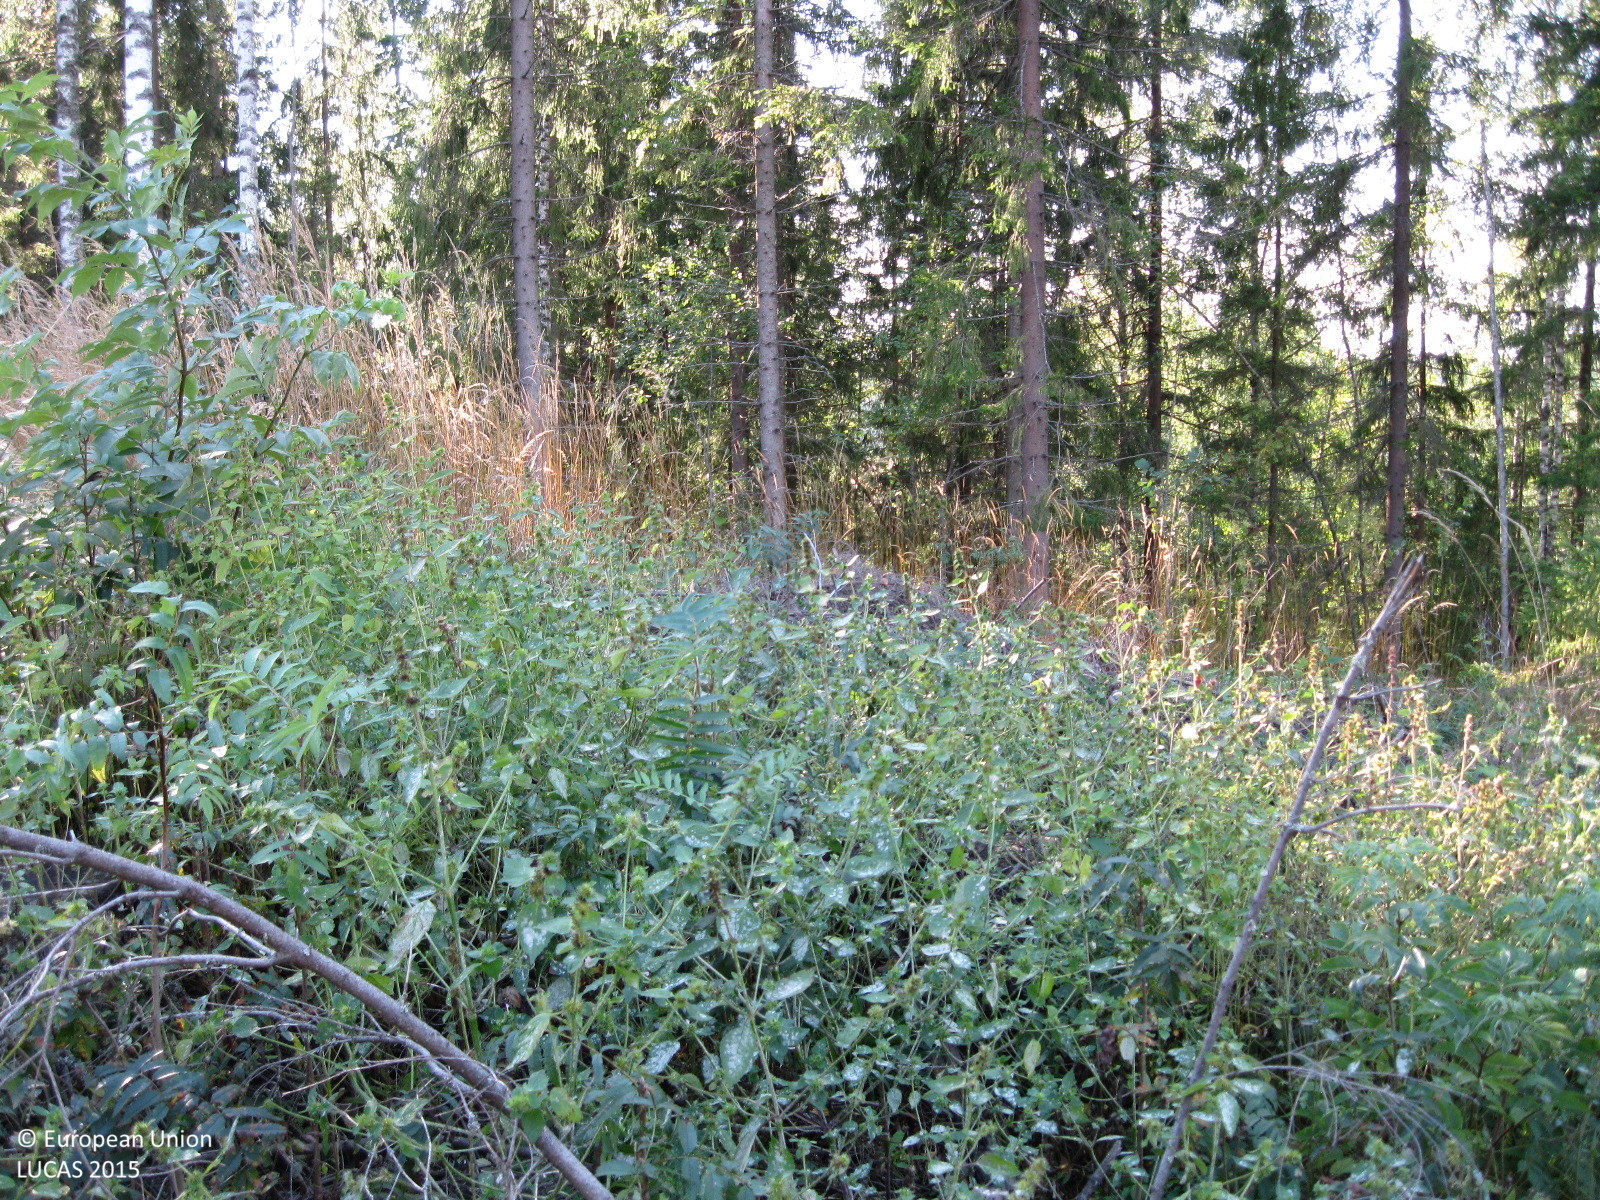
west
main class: Woodland
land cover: Broadleaved woodland
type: boreal forest
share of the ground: > 75 %
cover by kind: herbaceous plants 85 %, broadleaved forest trees 10 %, shrubs 5 %
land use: Forestry
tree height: > 5 m
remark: Nursery
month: September
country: FI
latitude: 60.5167
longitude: 24.7752
